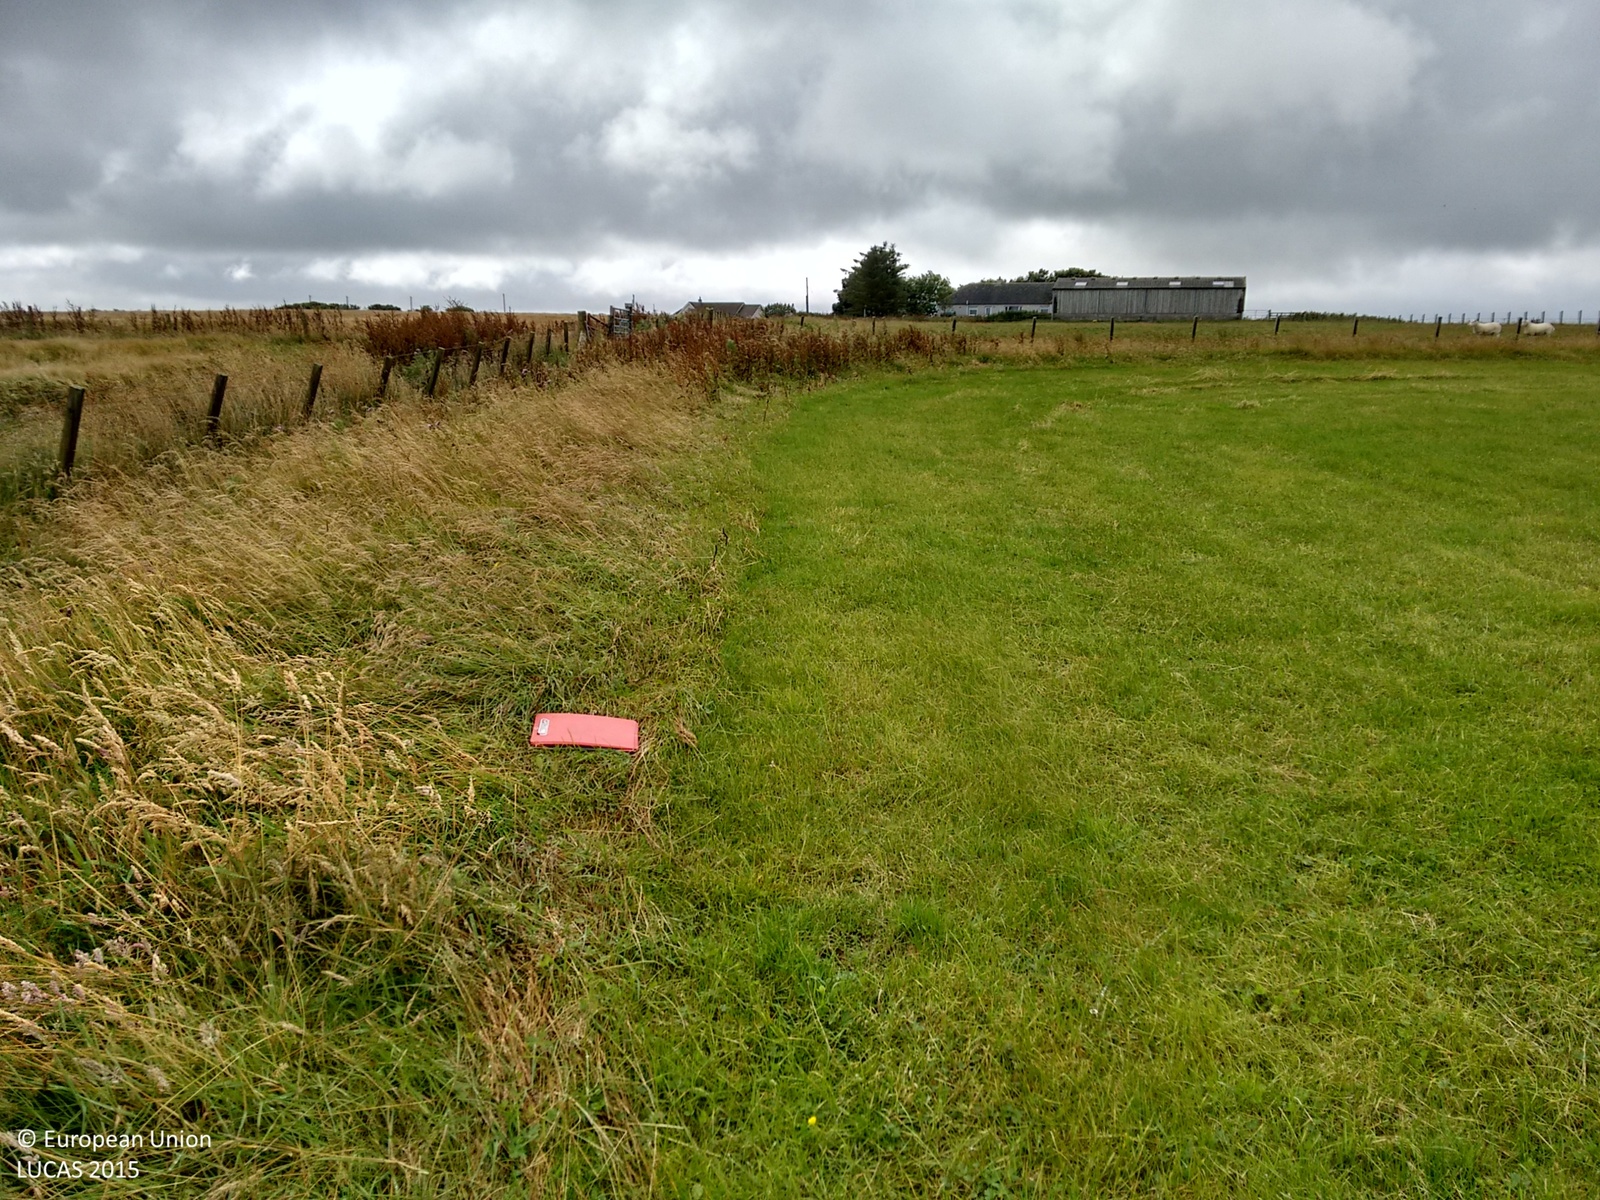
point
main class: Grassland
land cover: Grassland without tree/shrub cover
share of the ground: > 75 %
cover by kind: herbaceous plants 100 %
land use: Agriculture (excluding fallow land and kitchen gardens)
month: August
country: GB
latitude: 58.5121
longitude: -3.2252
